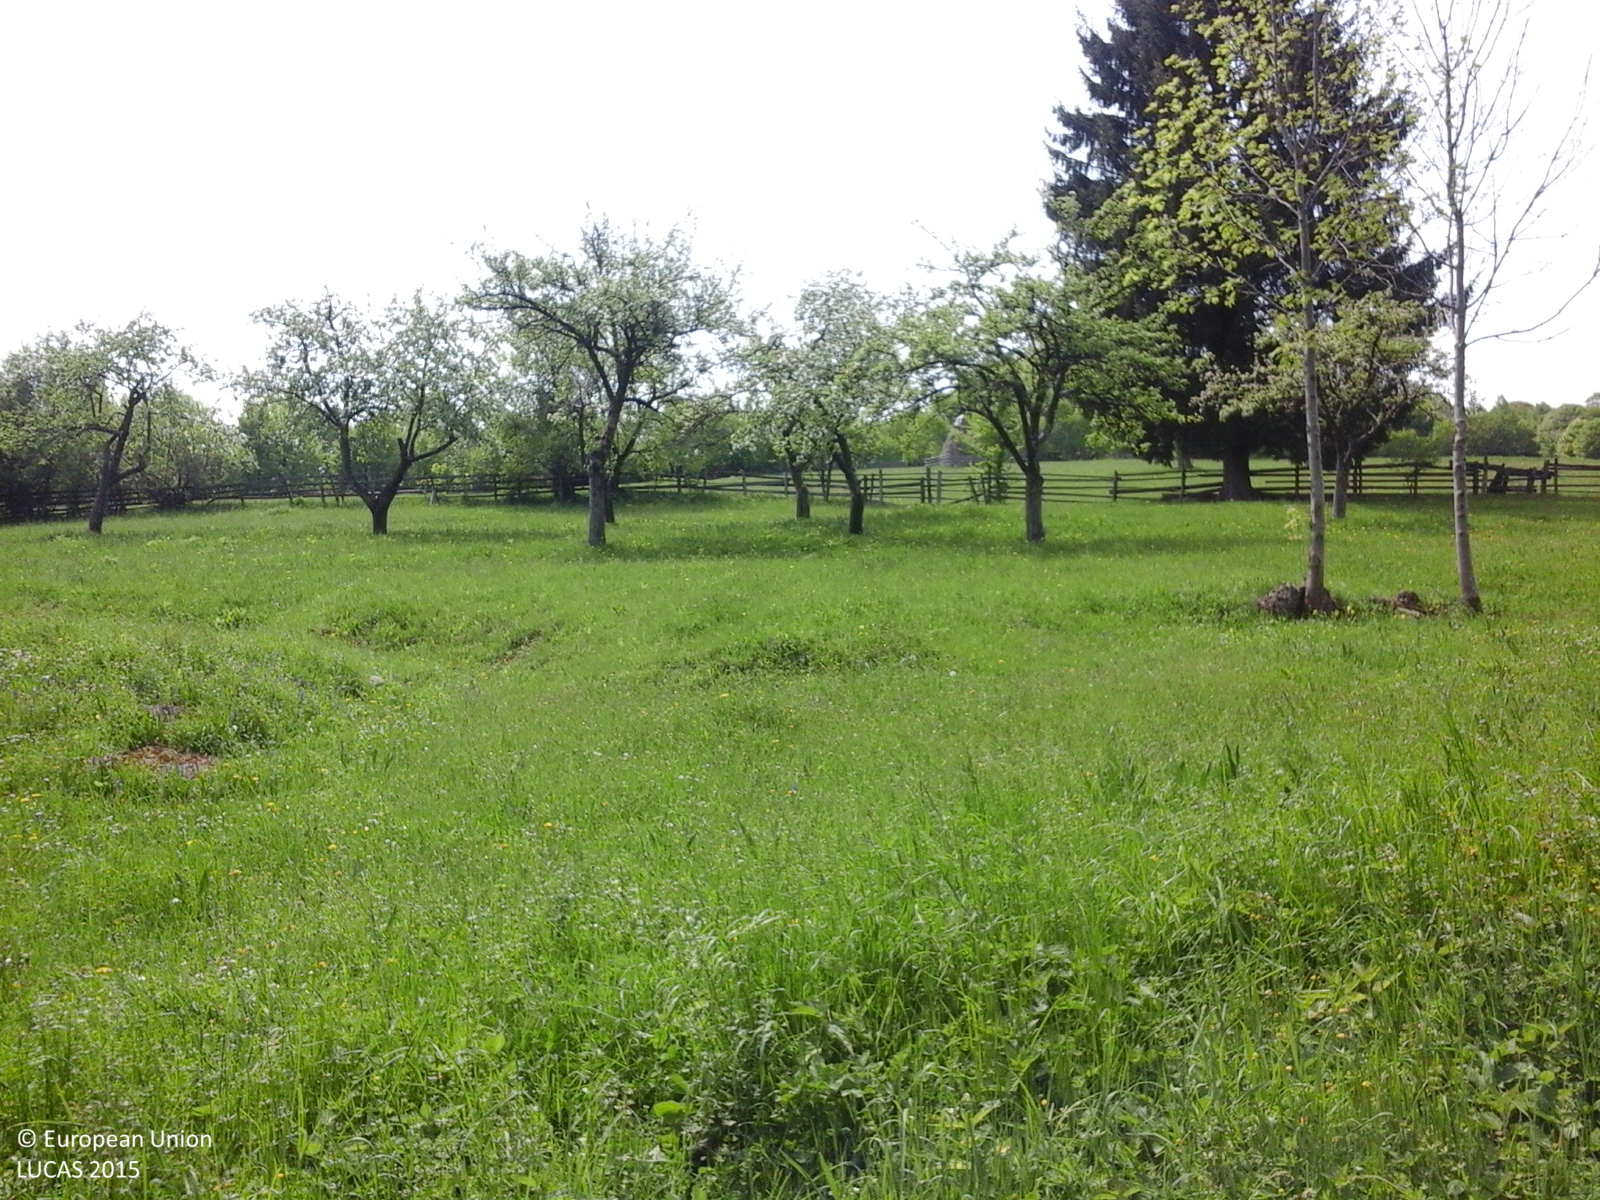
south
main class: Grassland
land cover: Grassland without tree/shrub cover
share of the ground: > 75 %
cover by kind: herbaceous plants 100 %
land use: Agriculture (excluding fallow land and kitchen gardens)
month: May
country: RO
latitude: 45.6371
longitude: 26.0881
